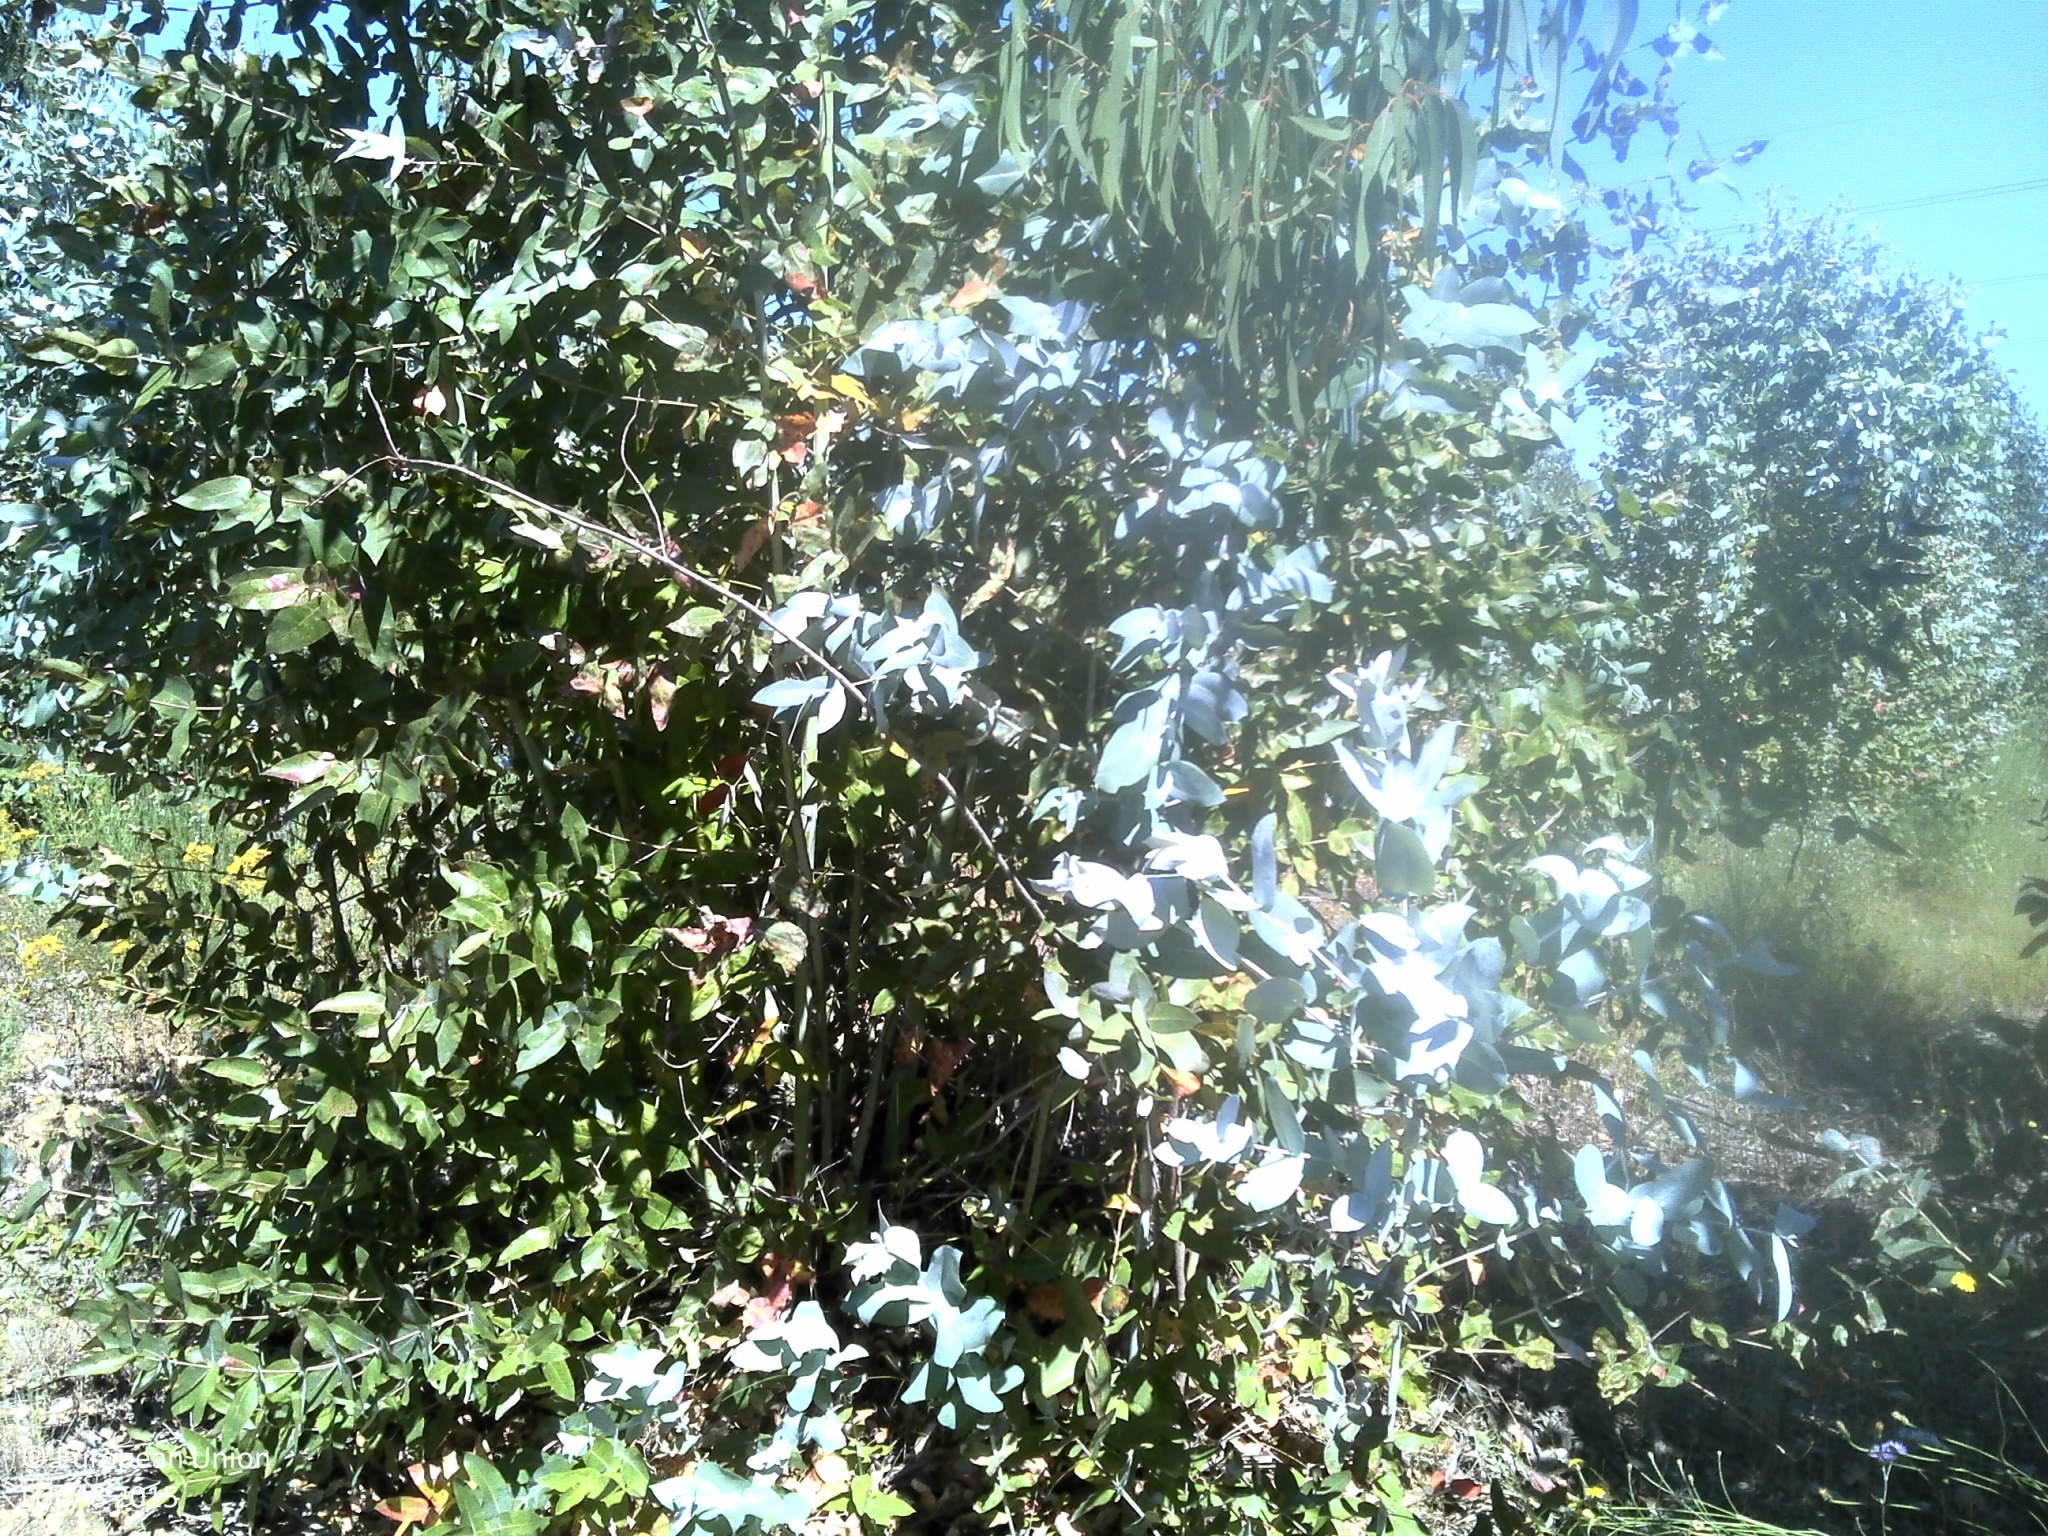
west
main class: Woodland
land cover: Broadleaved woodland
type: exotic forest
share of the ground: 50 - 75 %
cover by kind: broadleaved forest trees 70 %, herbaceous plants 15 %, unconsolidated bare surface 15 %
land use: Forestry
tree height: > 5 m
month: May
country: PT
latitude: 39.4323
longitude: -8.3177
